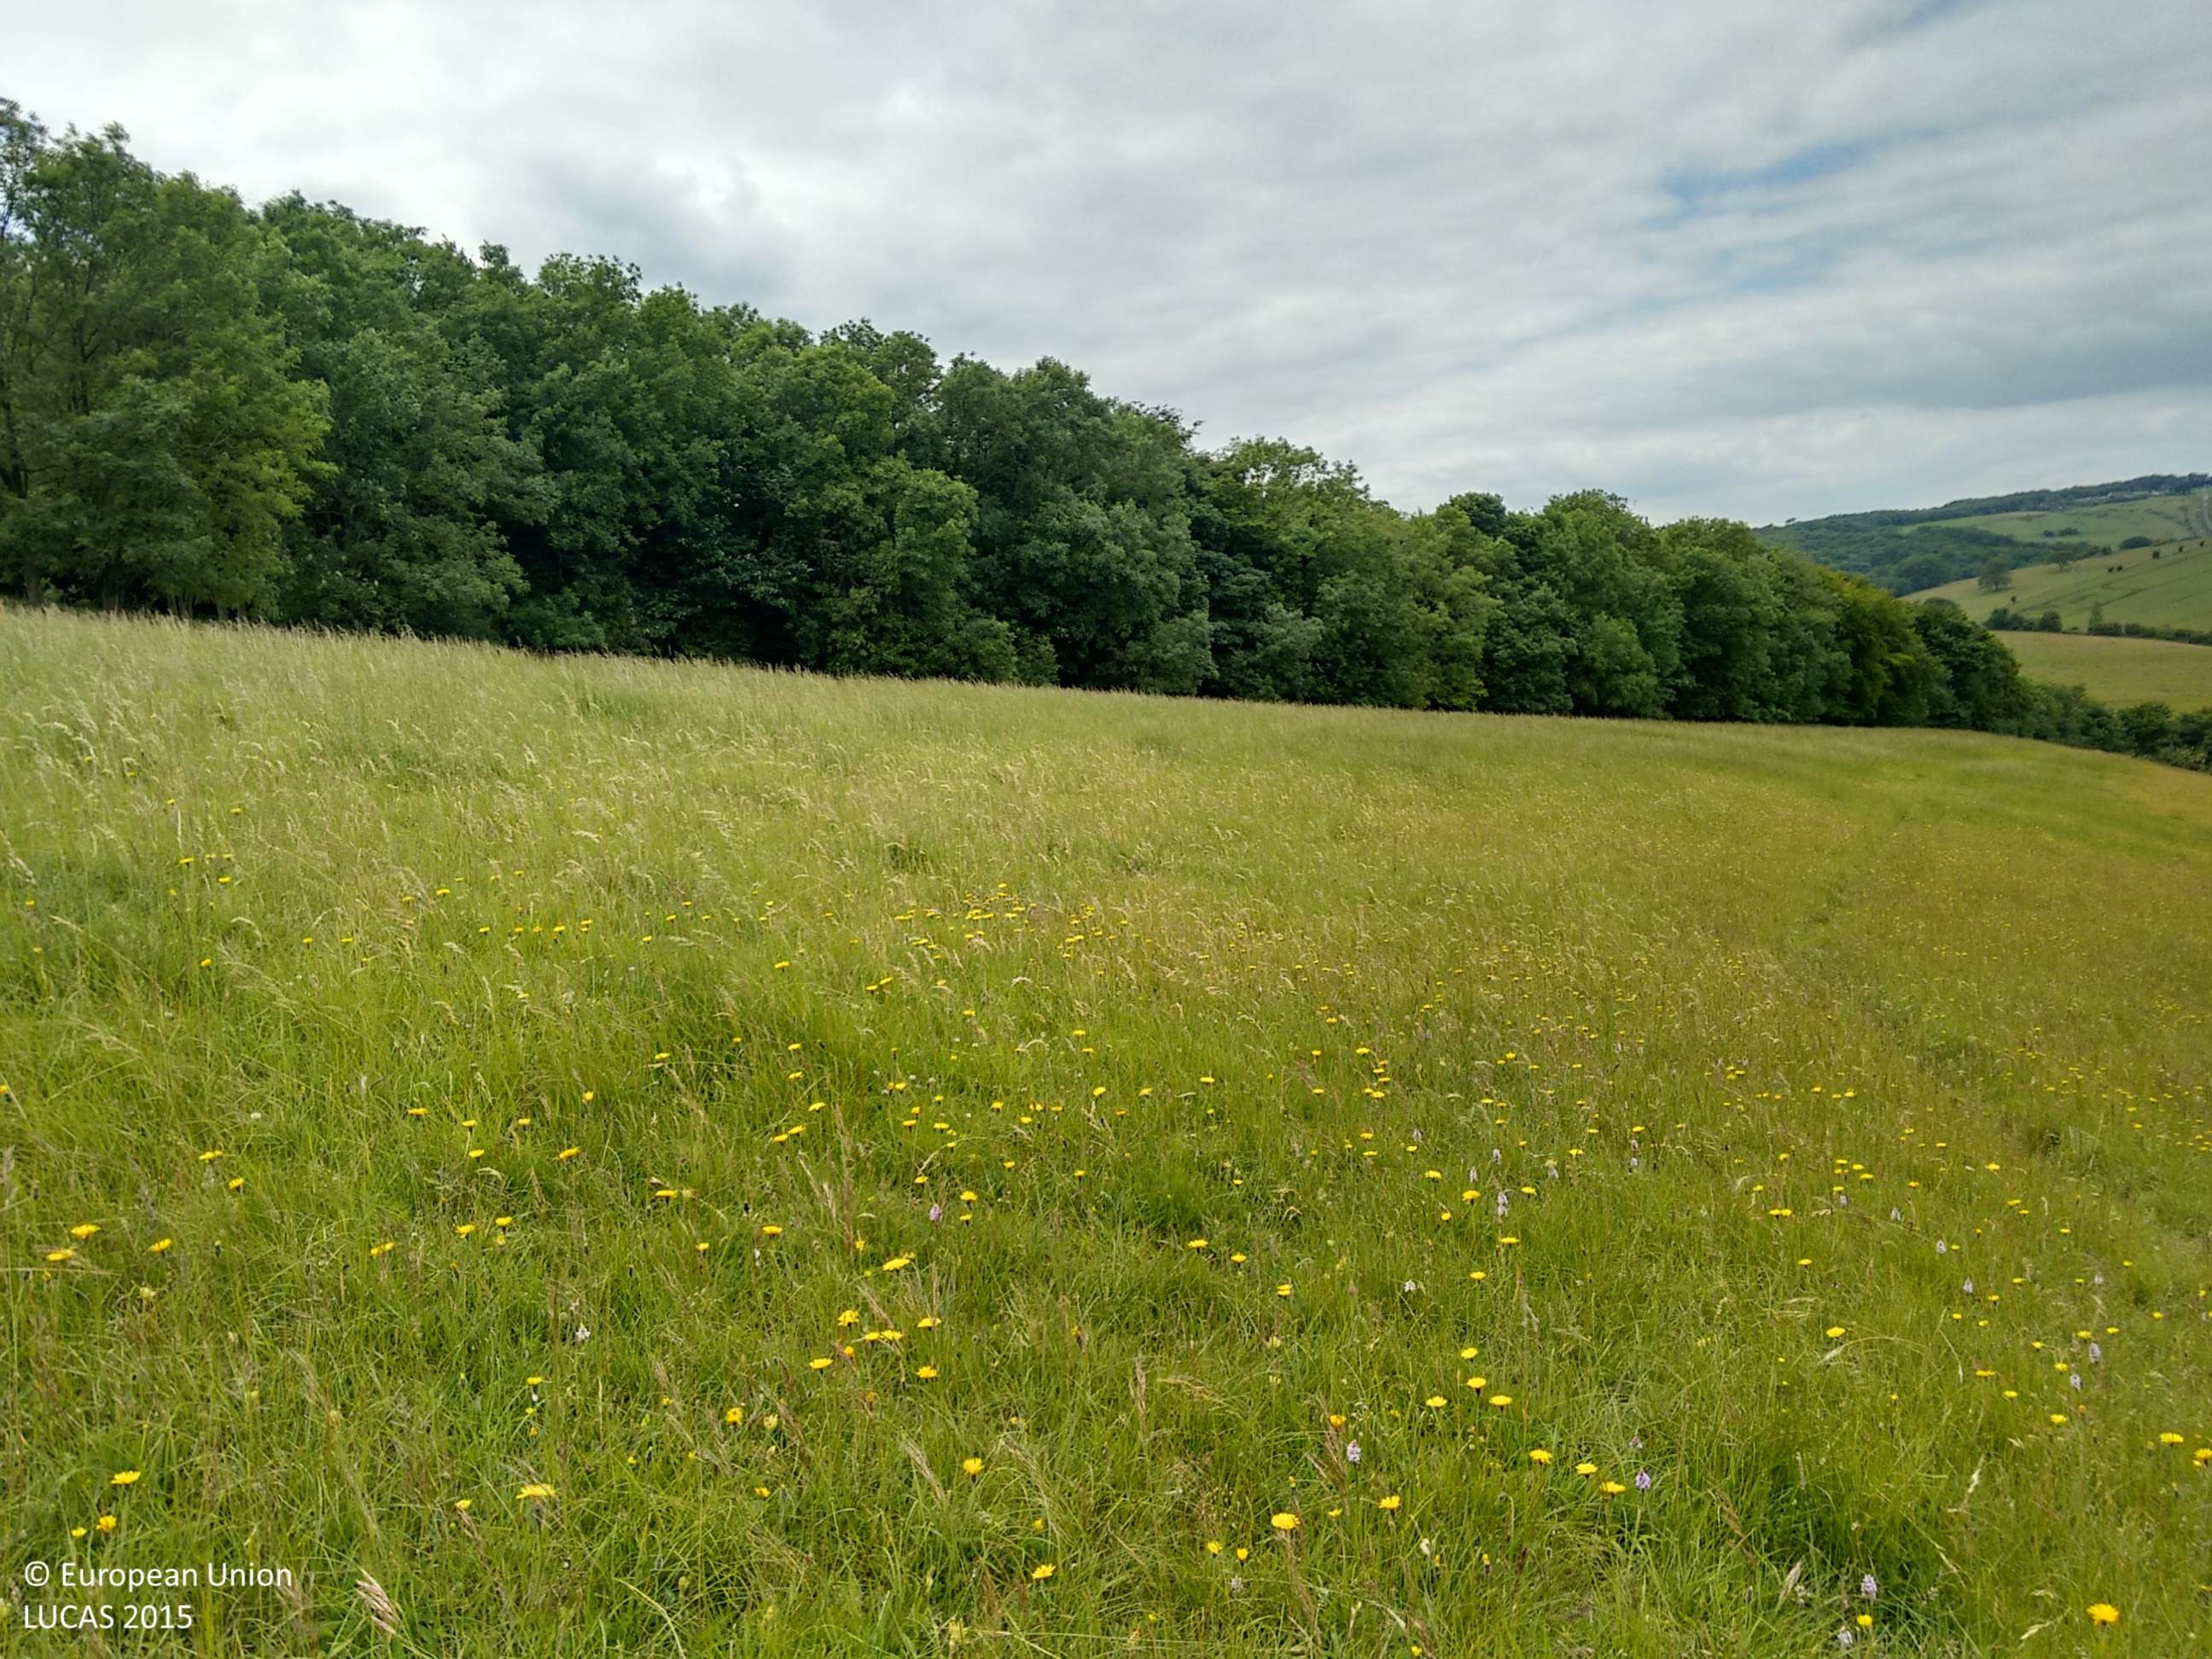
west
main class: Grassland
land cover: Grassland without tree/shrub cover
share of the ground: > 75 %
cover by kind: herbaceous plants 100 %
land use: Agriculture (excluding fallow land and kitchen gardens)
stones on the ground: < 10 %
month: June
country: GB
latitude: 50.8780
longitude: -0.0818
